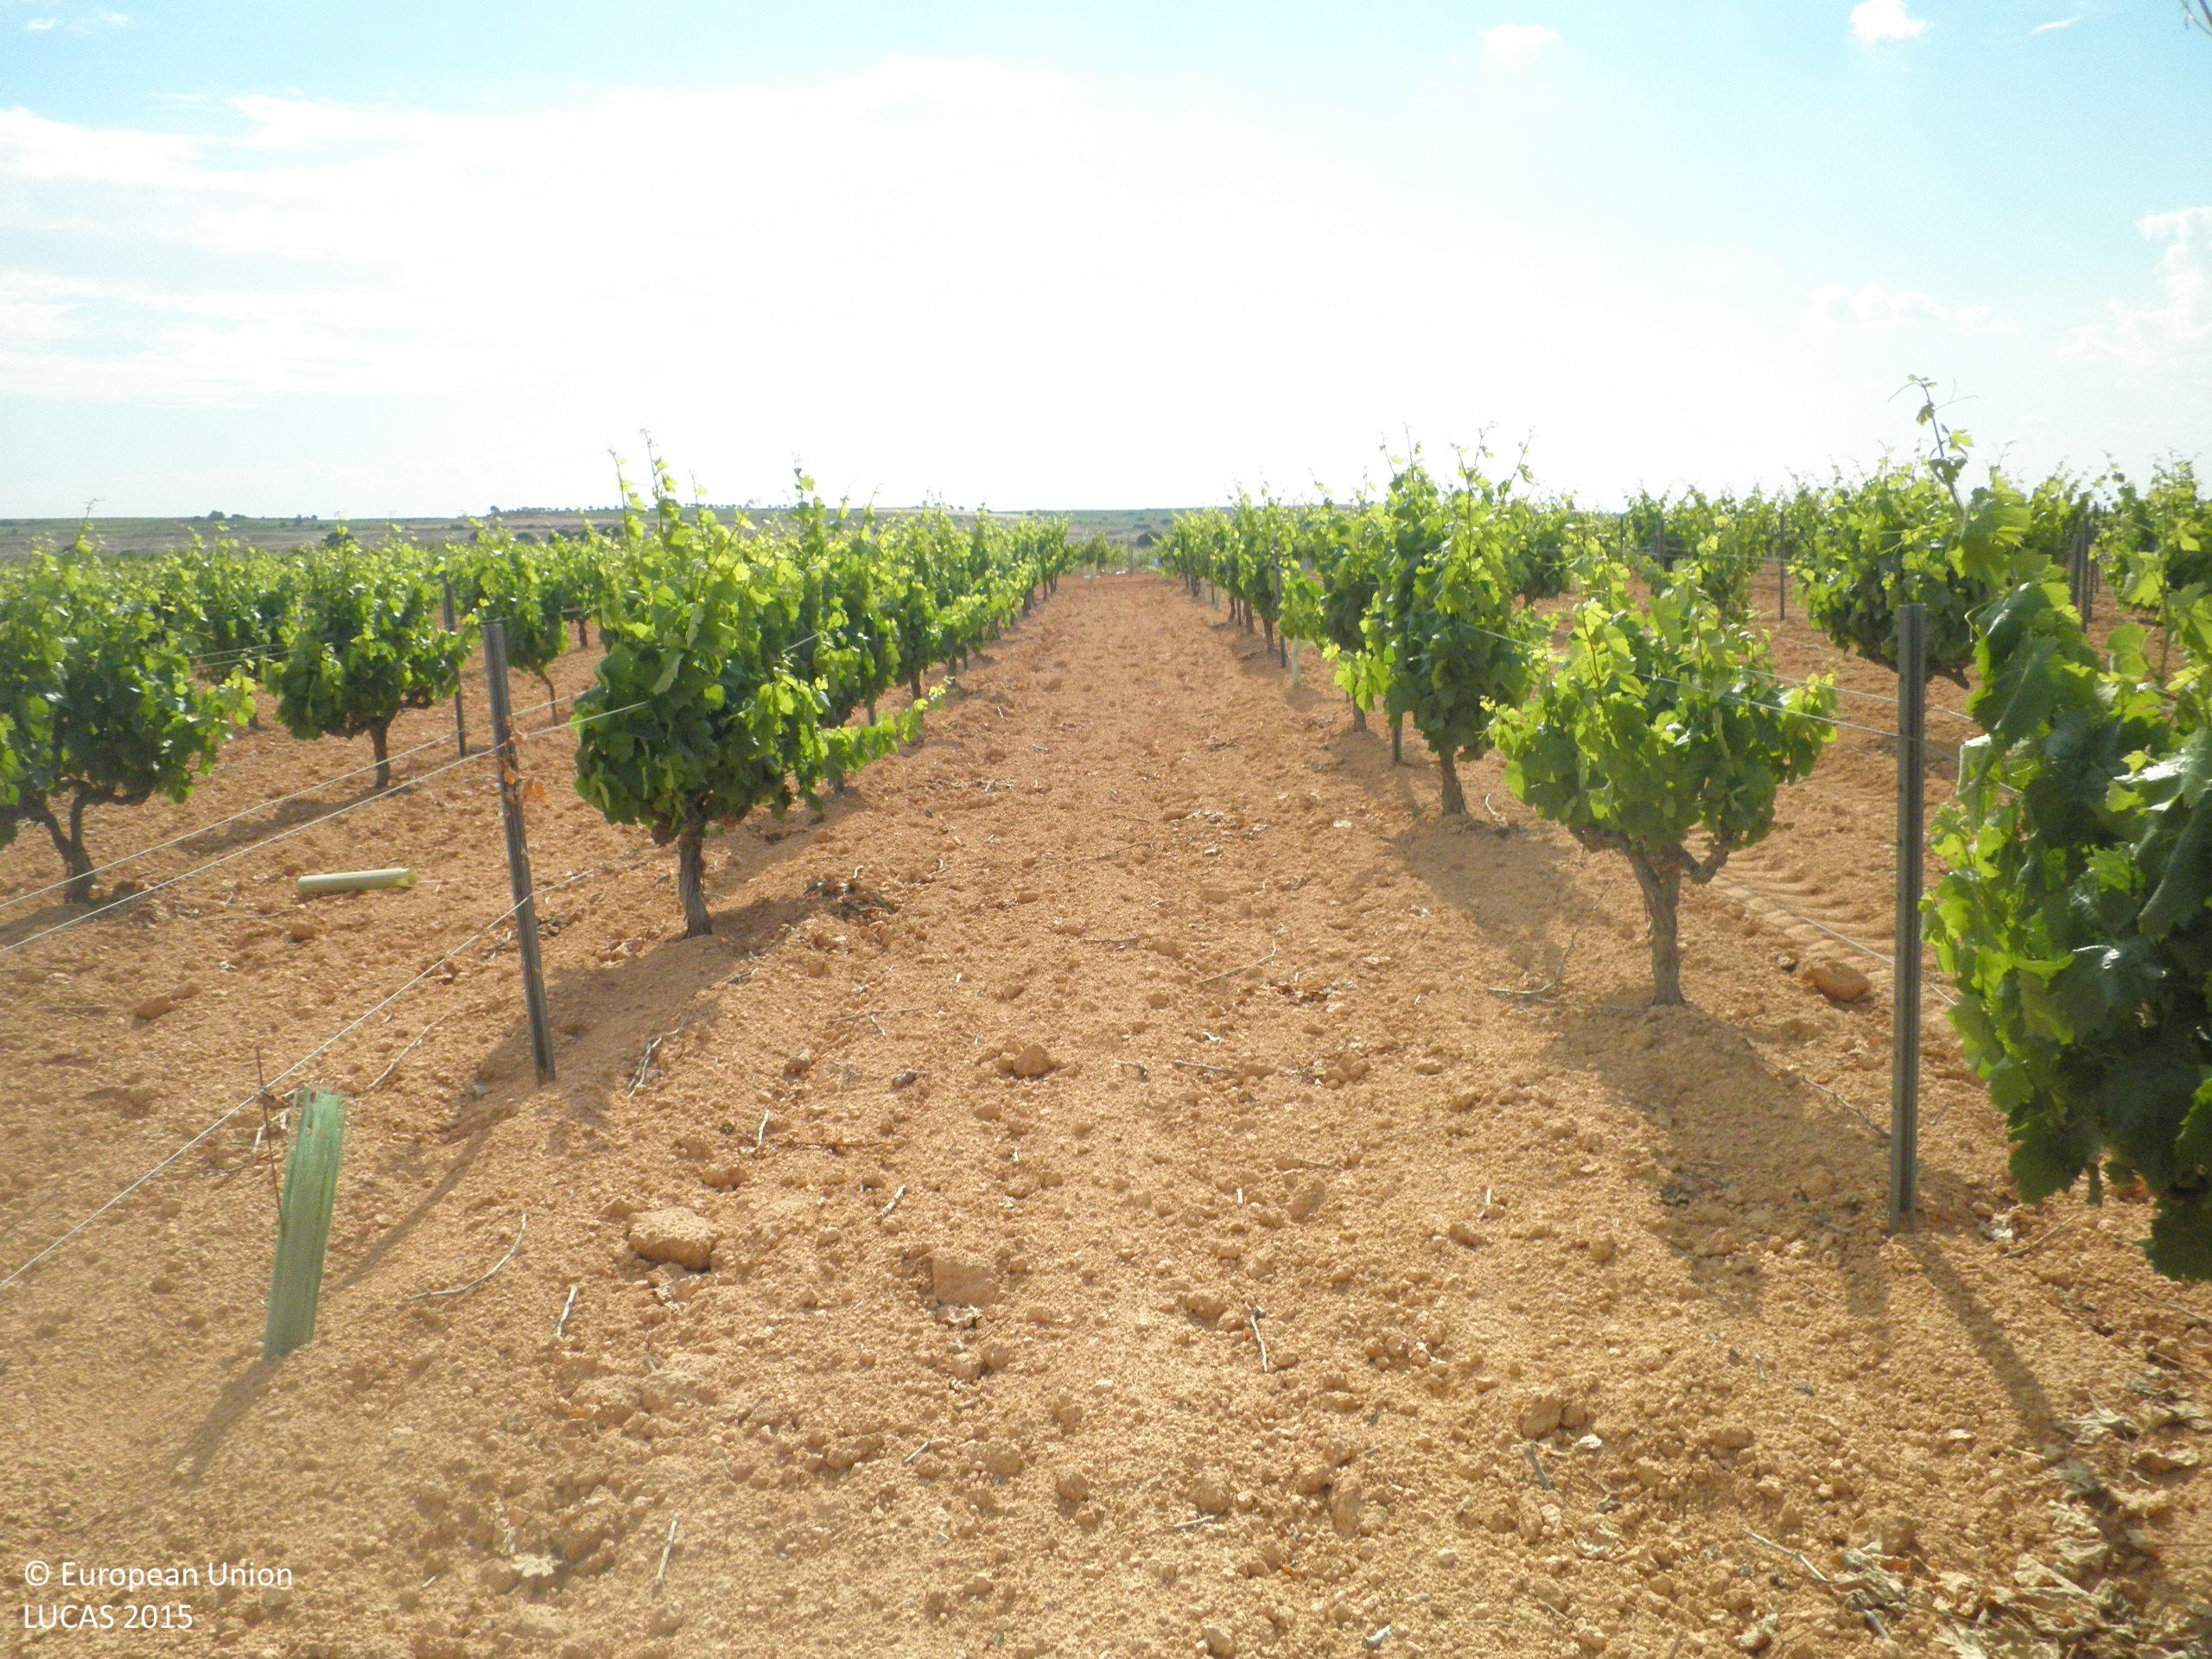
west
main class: Cropland
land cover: Vineyards
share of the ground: < 10 %
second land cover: Other bare soil
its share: > 75 %
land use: Agriculture (excluding fallow land and kitchen gardens)
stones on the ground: < 10 %
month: June
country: ES
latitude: 39.3139
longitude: -1.6590
